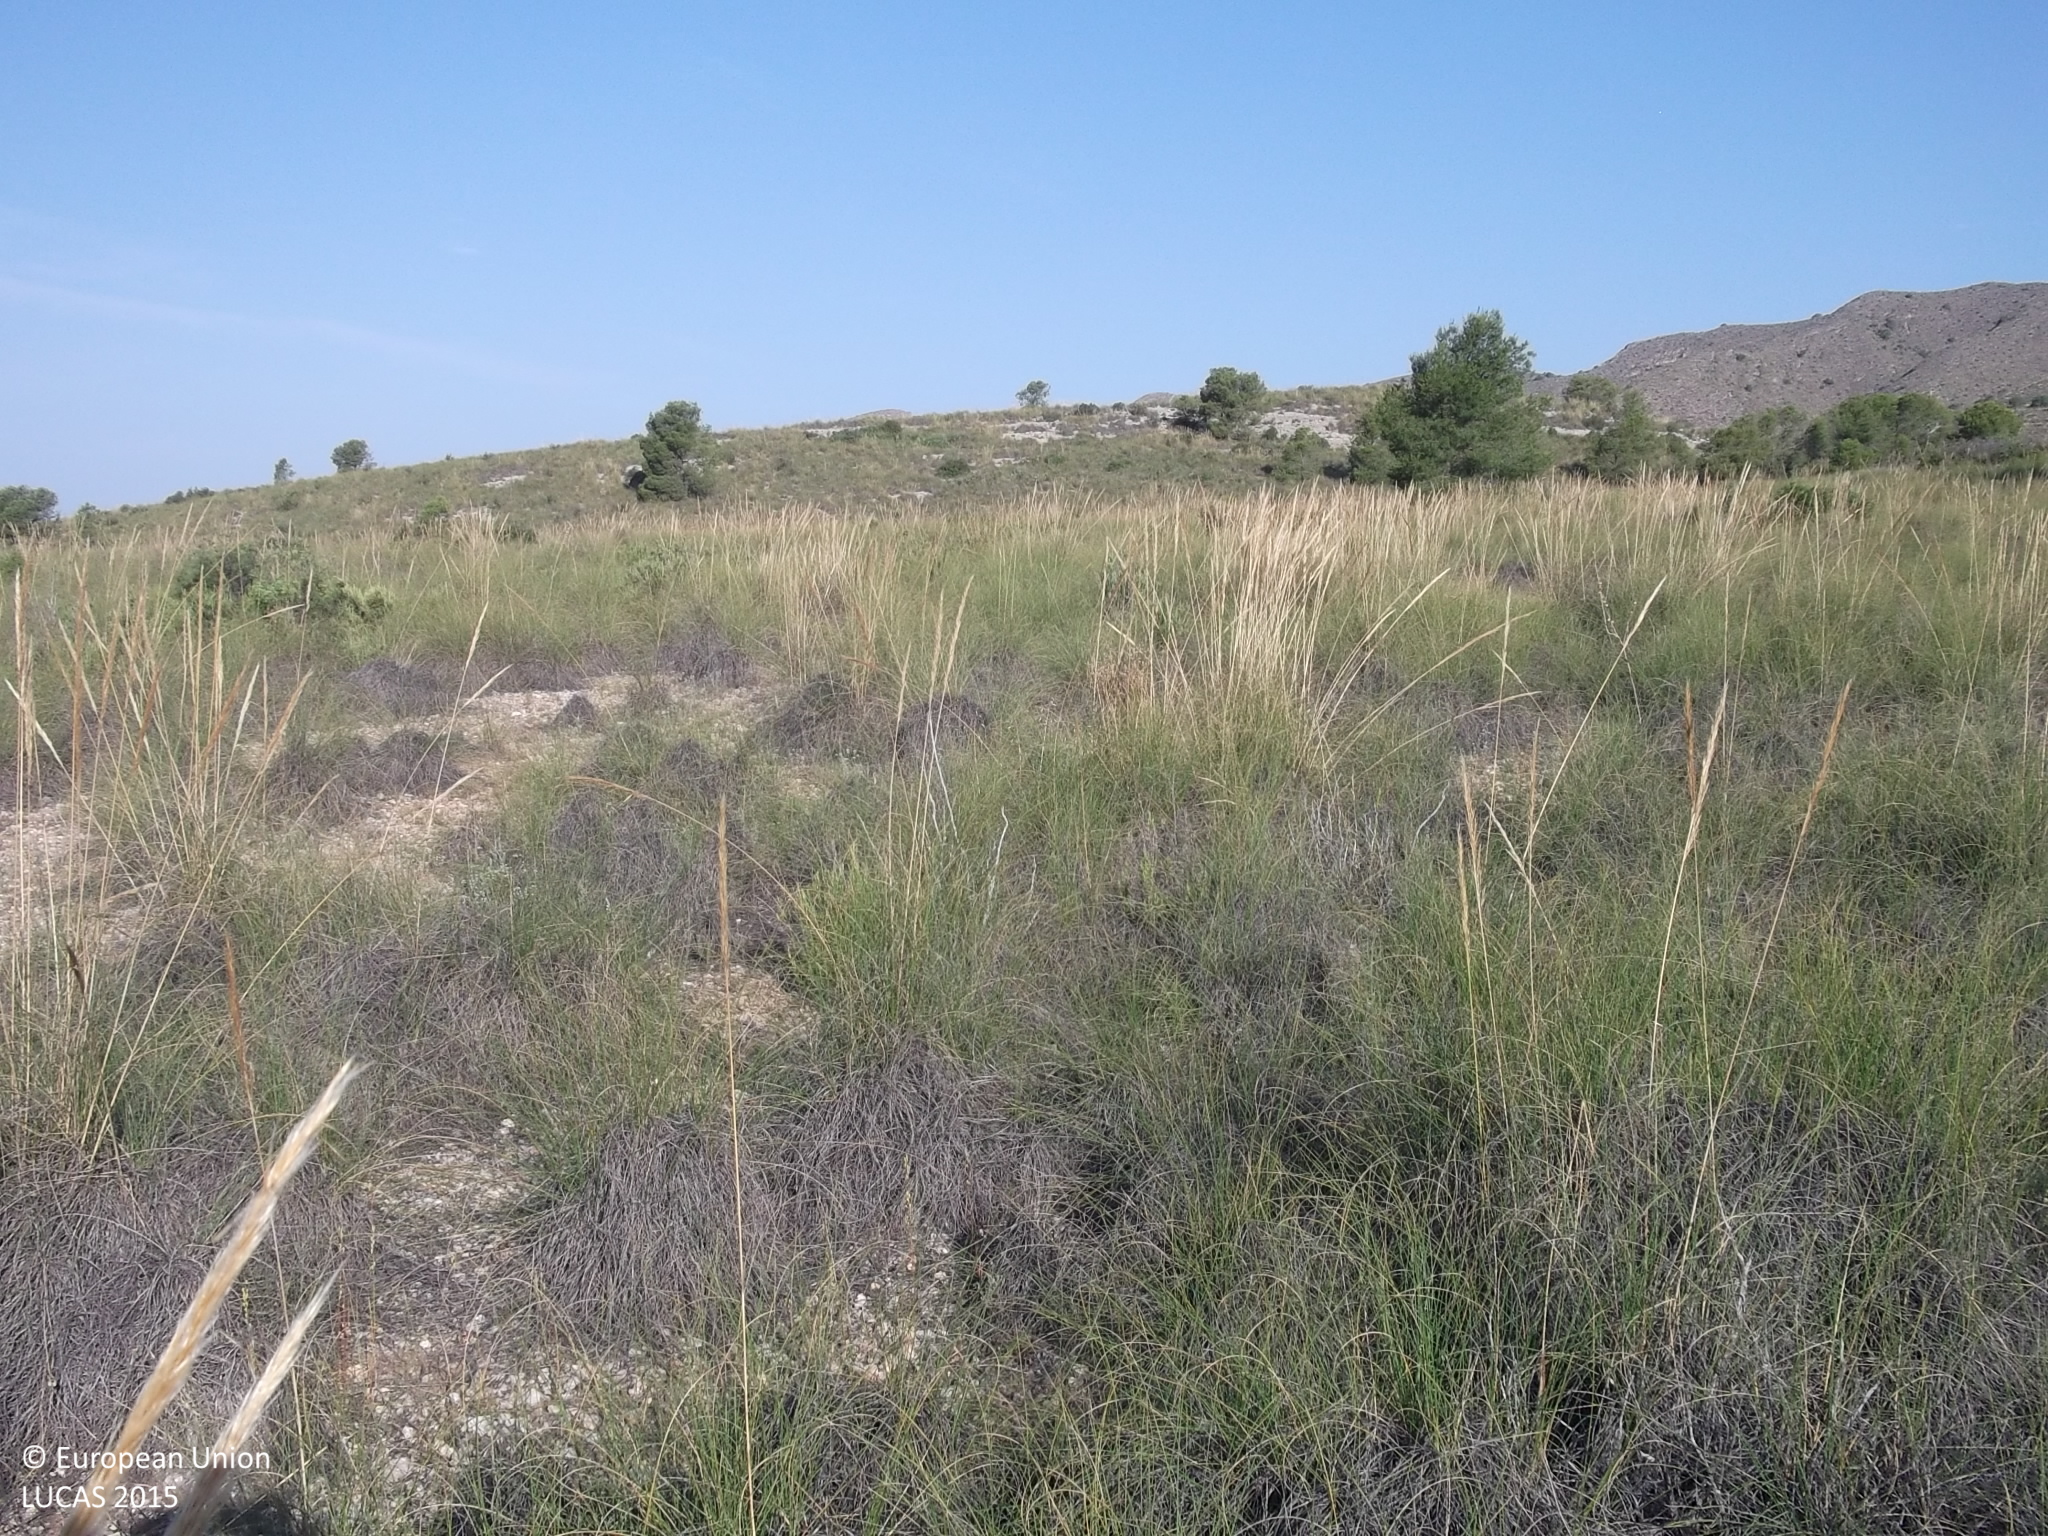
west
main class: Grassland
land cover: Grassland with sparse tree/shrub cover
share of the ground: 25 - 50 %
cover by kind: herbaceous plants 45 %, consolidated bare surface 40 %, shrubs 10 %, coniferous forest trees 5 %
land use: Abandoned areas
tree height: > 5 m
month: June
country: ES
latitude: 38.3458
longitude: -1.3512
